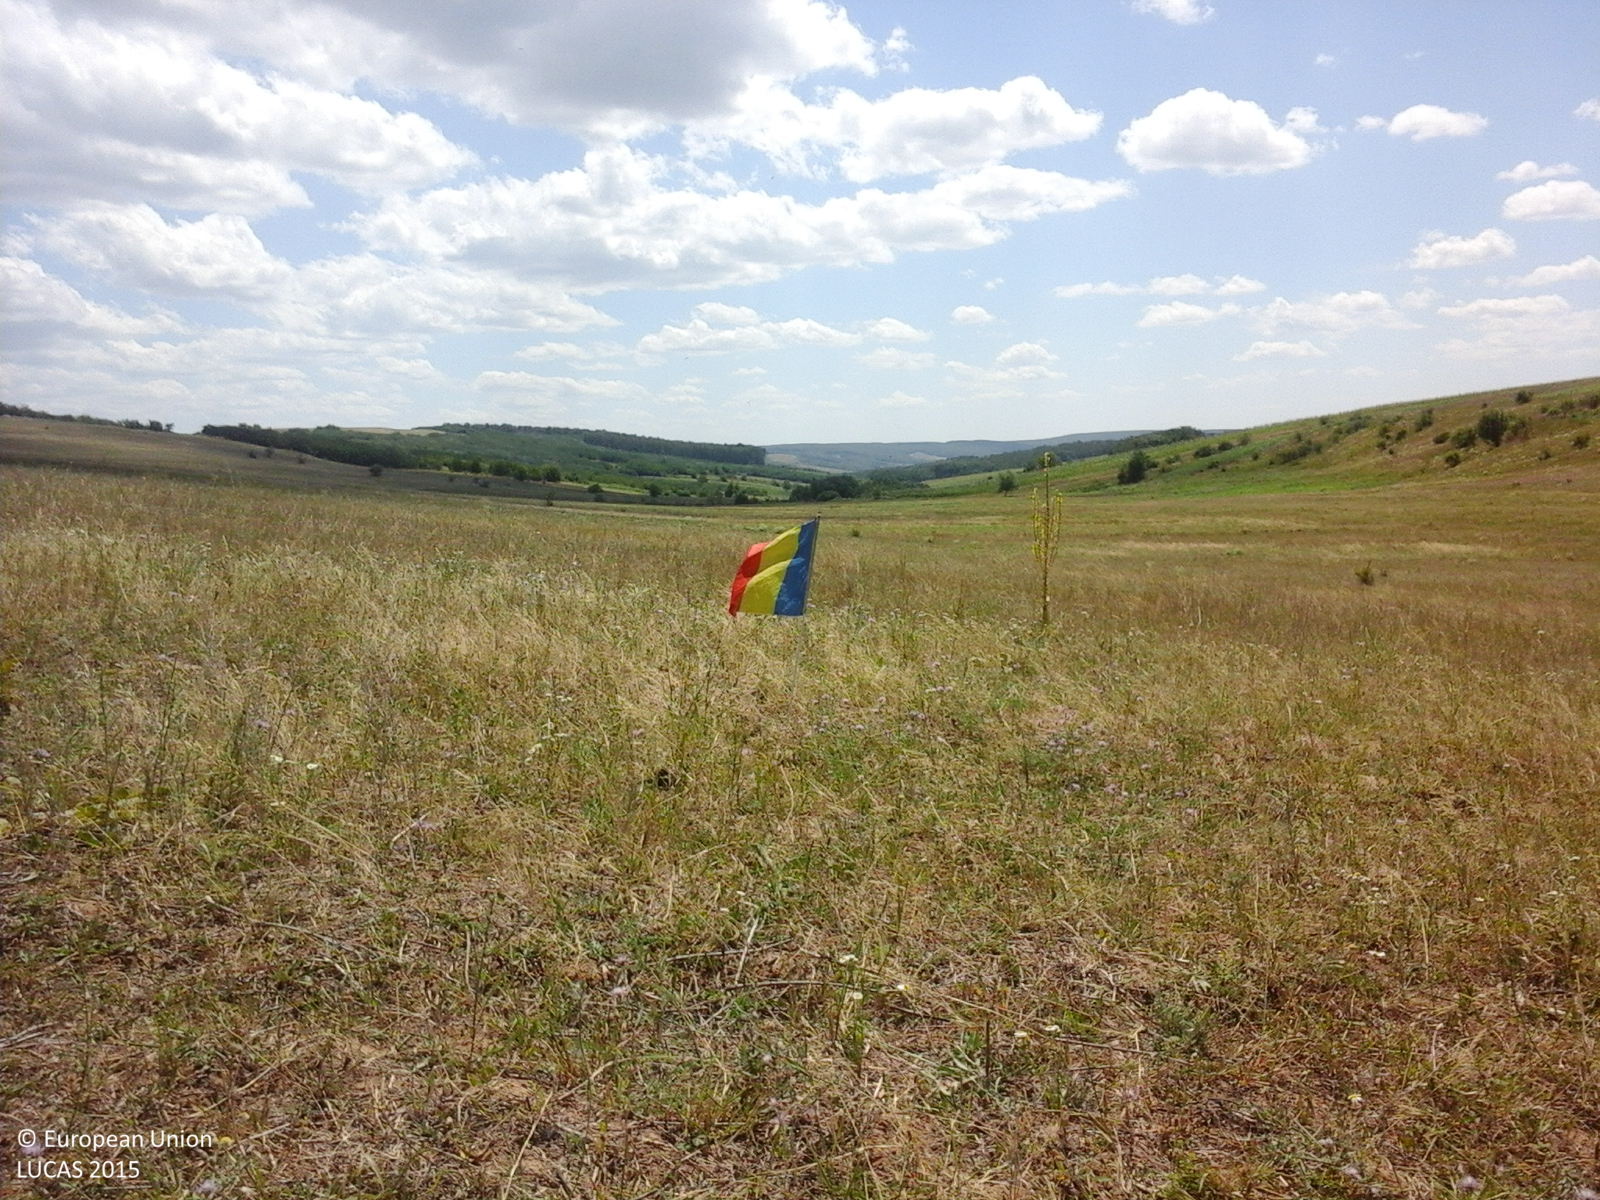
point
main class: Grassland
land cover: Grassland without tree/shrub cover
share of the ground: > 75 %
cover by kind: herbaceous plants 100 %
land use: Agriculture (excluding fallow land and kitchen gardens)
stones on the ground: < 10 %
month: July
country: RO
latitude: 46.1961
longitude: 27.8593
